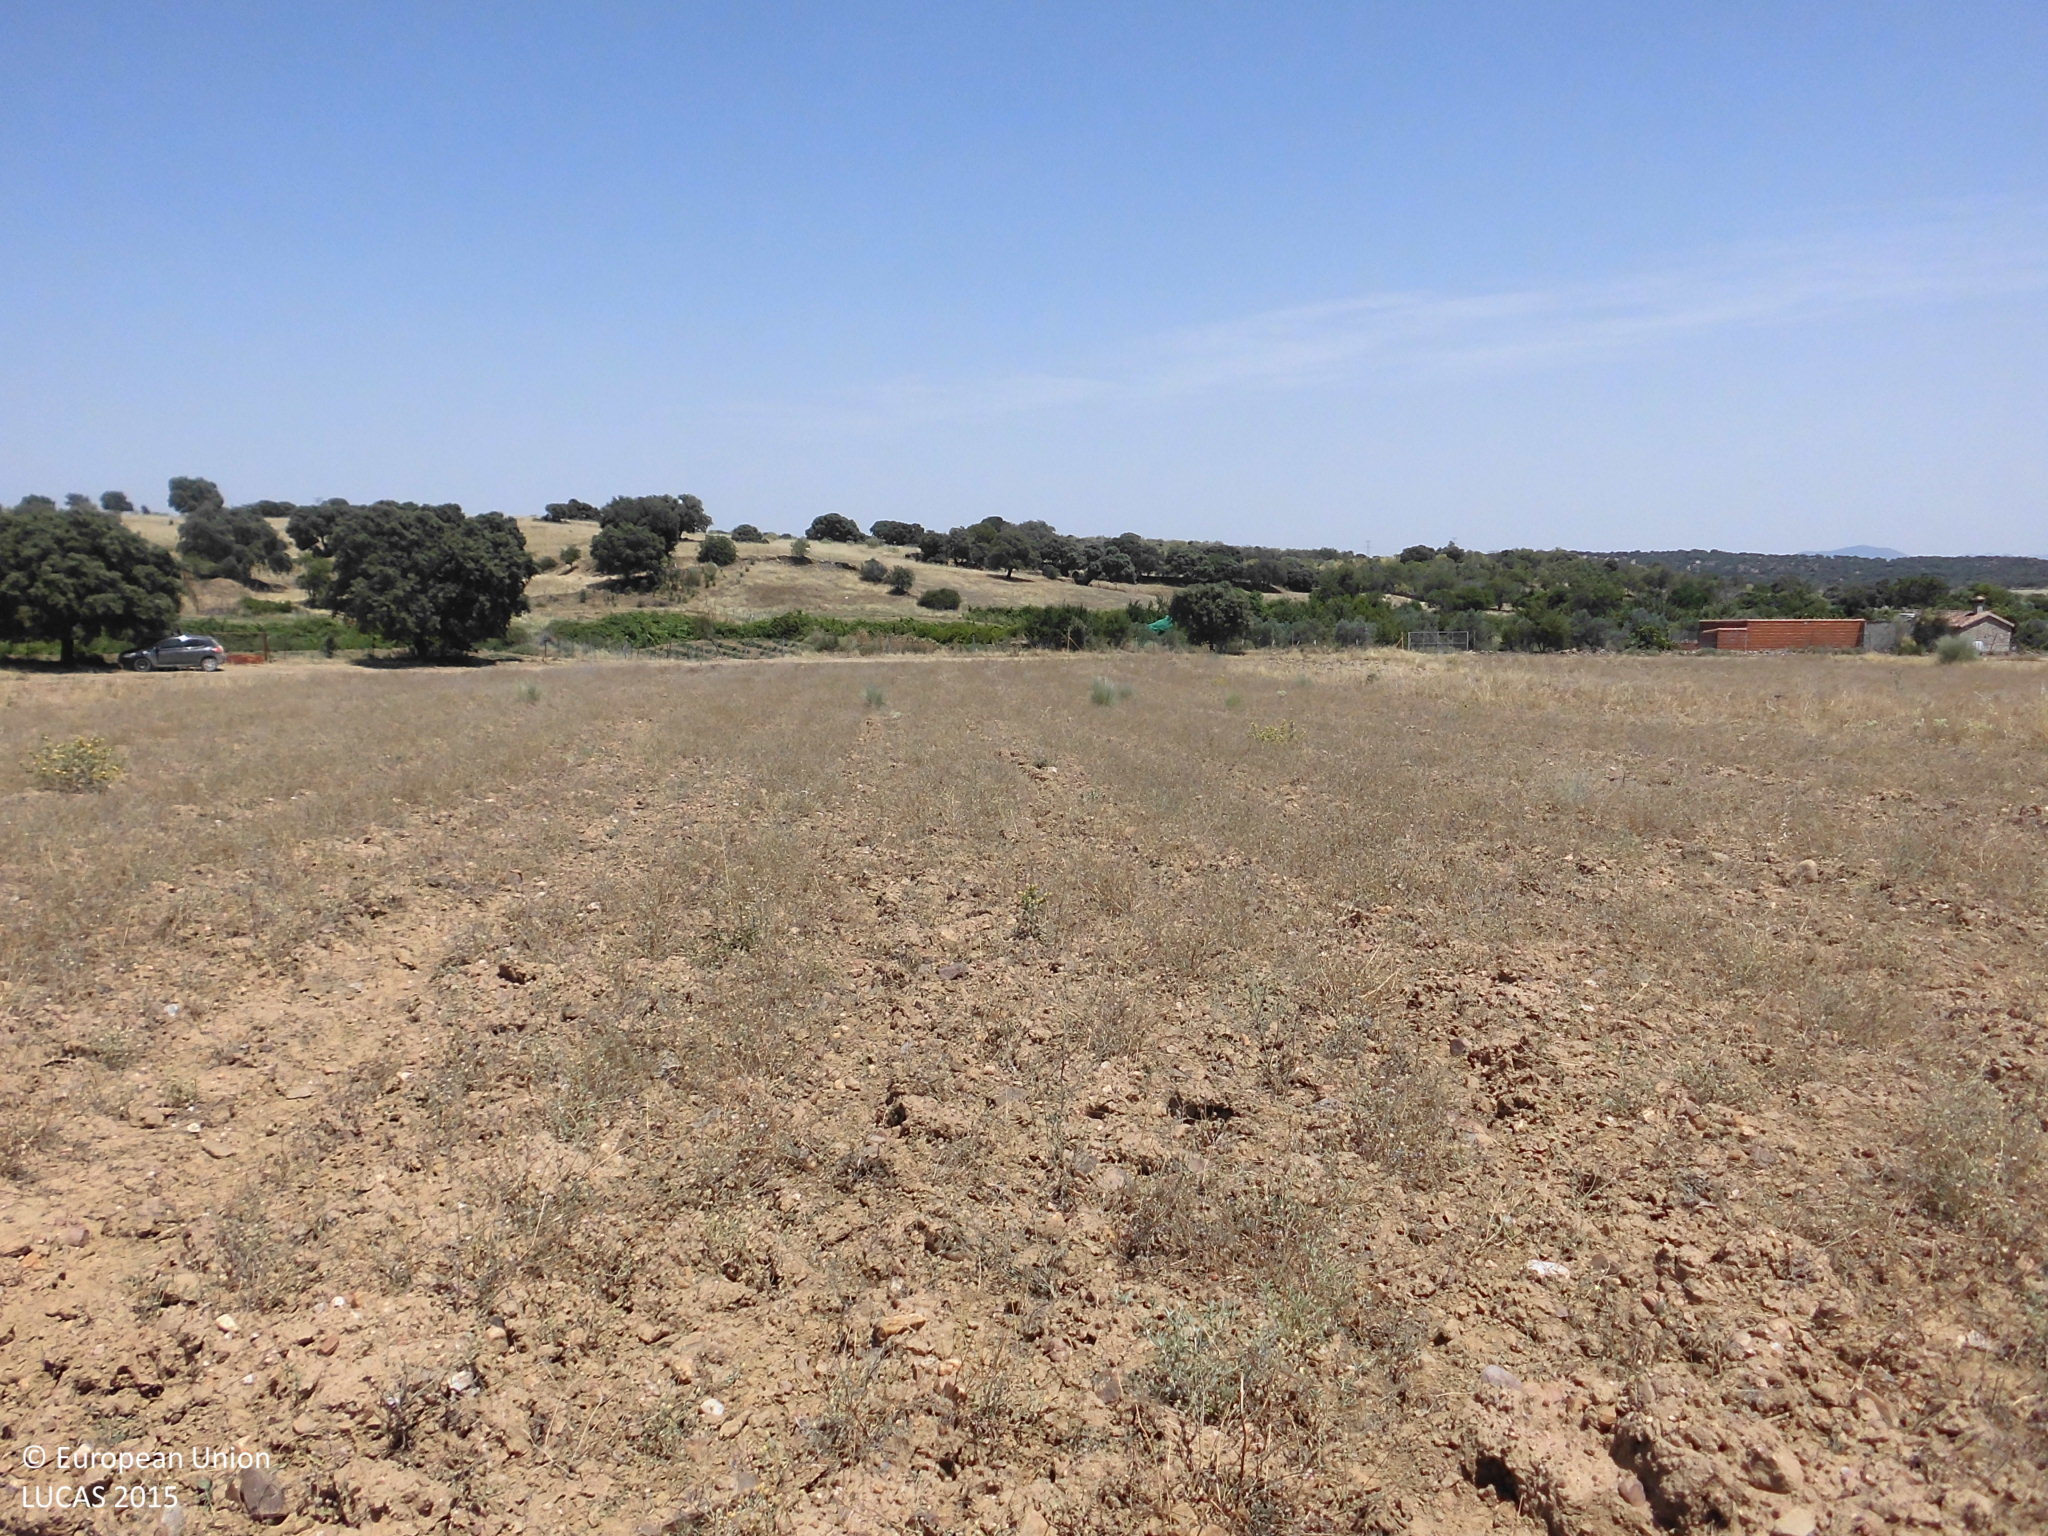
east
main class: Grassland
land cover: Spontaneously vegetated surfaces
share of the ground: 25 - 50 %
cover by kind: herbaceous plants 30 %
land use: Fallow land
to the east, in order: Spontaneously vegetated surfaces; Fences; Tracks; Fences; Artificial constructions; Olive groves; Fences; Shruby margins; Rivers and streams; Abandoned hedges; Grassland without tree/shrub cover; Grass margins; Grassland without tree/shrub cover
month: July
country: ES
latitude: 39.7455
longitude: -5.3765
